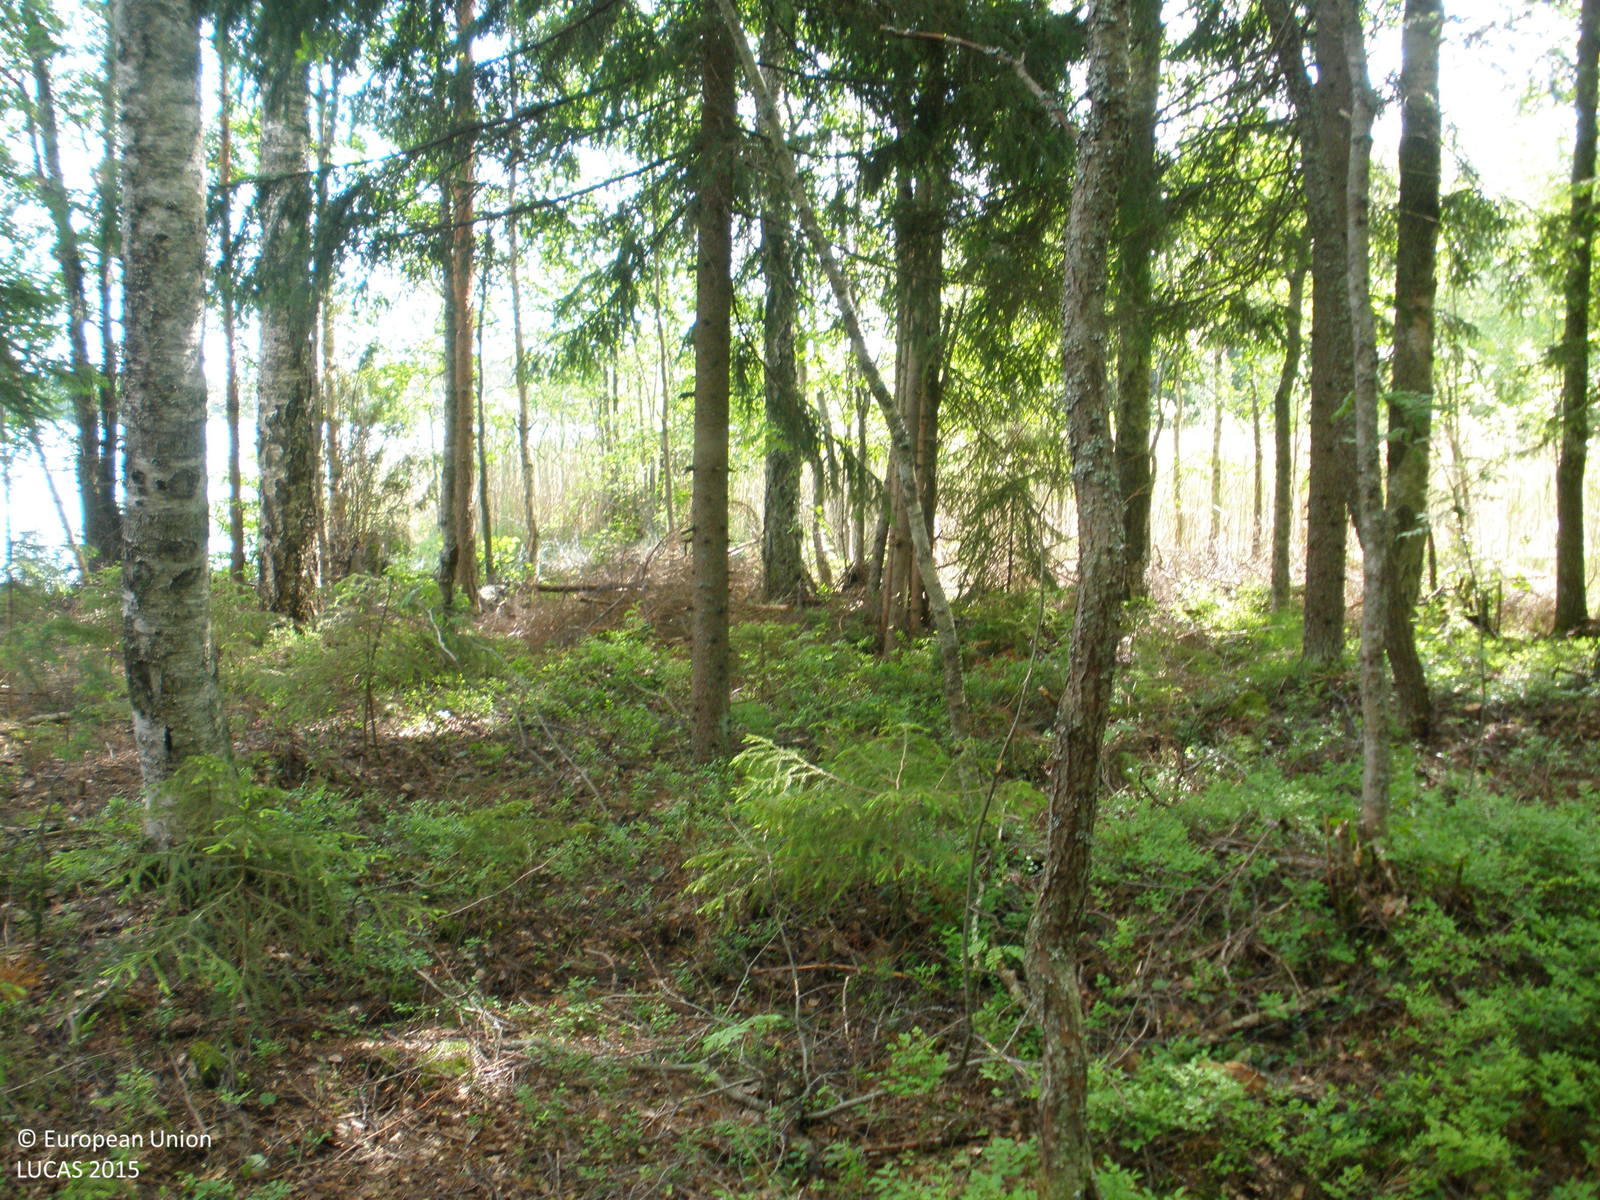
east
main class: Woodland
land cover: Spruce dominated mixed woodland
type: boreal forest
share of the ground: > 75 %
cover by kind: broadleaved forest trees 50 %, coniferous forest trees 35 %, herbaceous plants 10 %, shrubs 5 %
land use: Forestry
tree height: > 5 m
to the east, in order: Spruce dominated mixed woodland; Inland fresh water bodies; Broadleaved woodland; Inland fresh water bodies
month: June
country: FI
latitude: 61.0011
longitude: 23.6023
